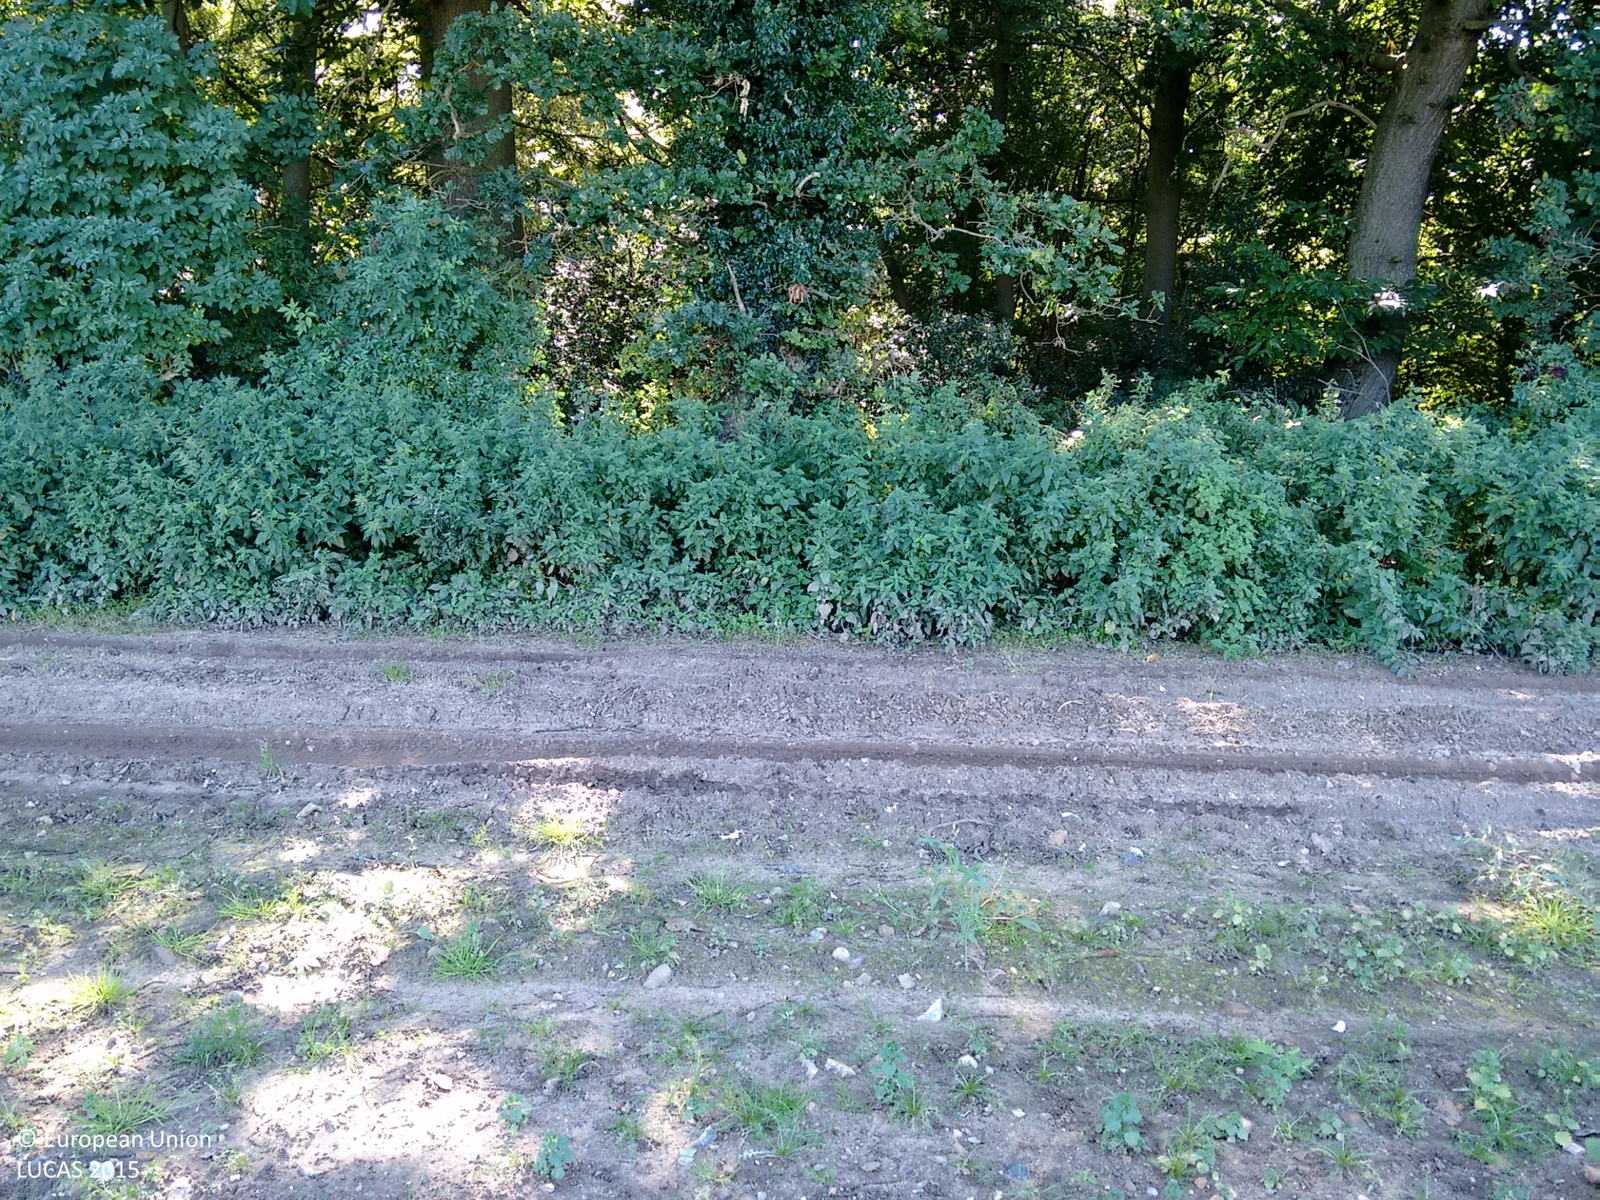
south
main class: Cropland
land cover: Other root crops
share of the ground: > 75 %
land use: Agriculture (excluding fallow land and kitchen gardens)
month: September
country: GB
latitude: 52.5280
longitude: 0.8218
